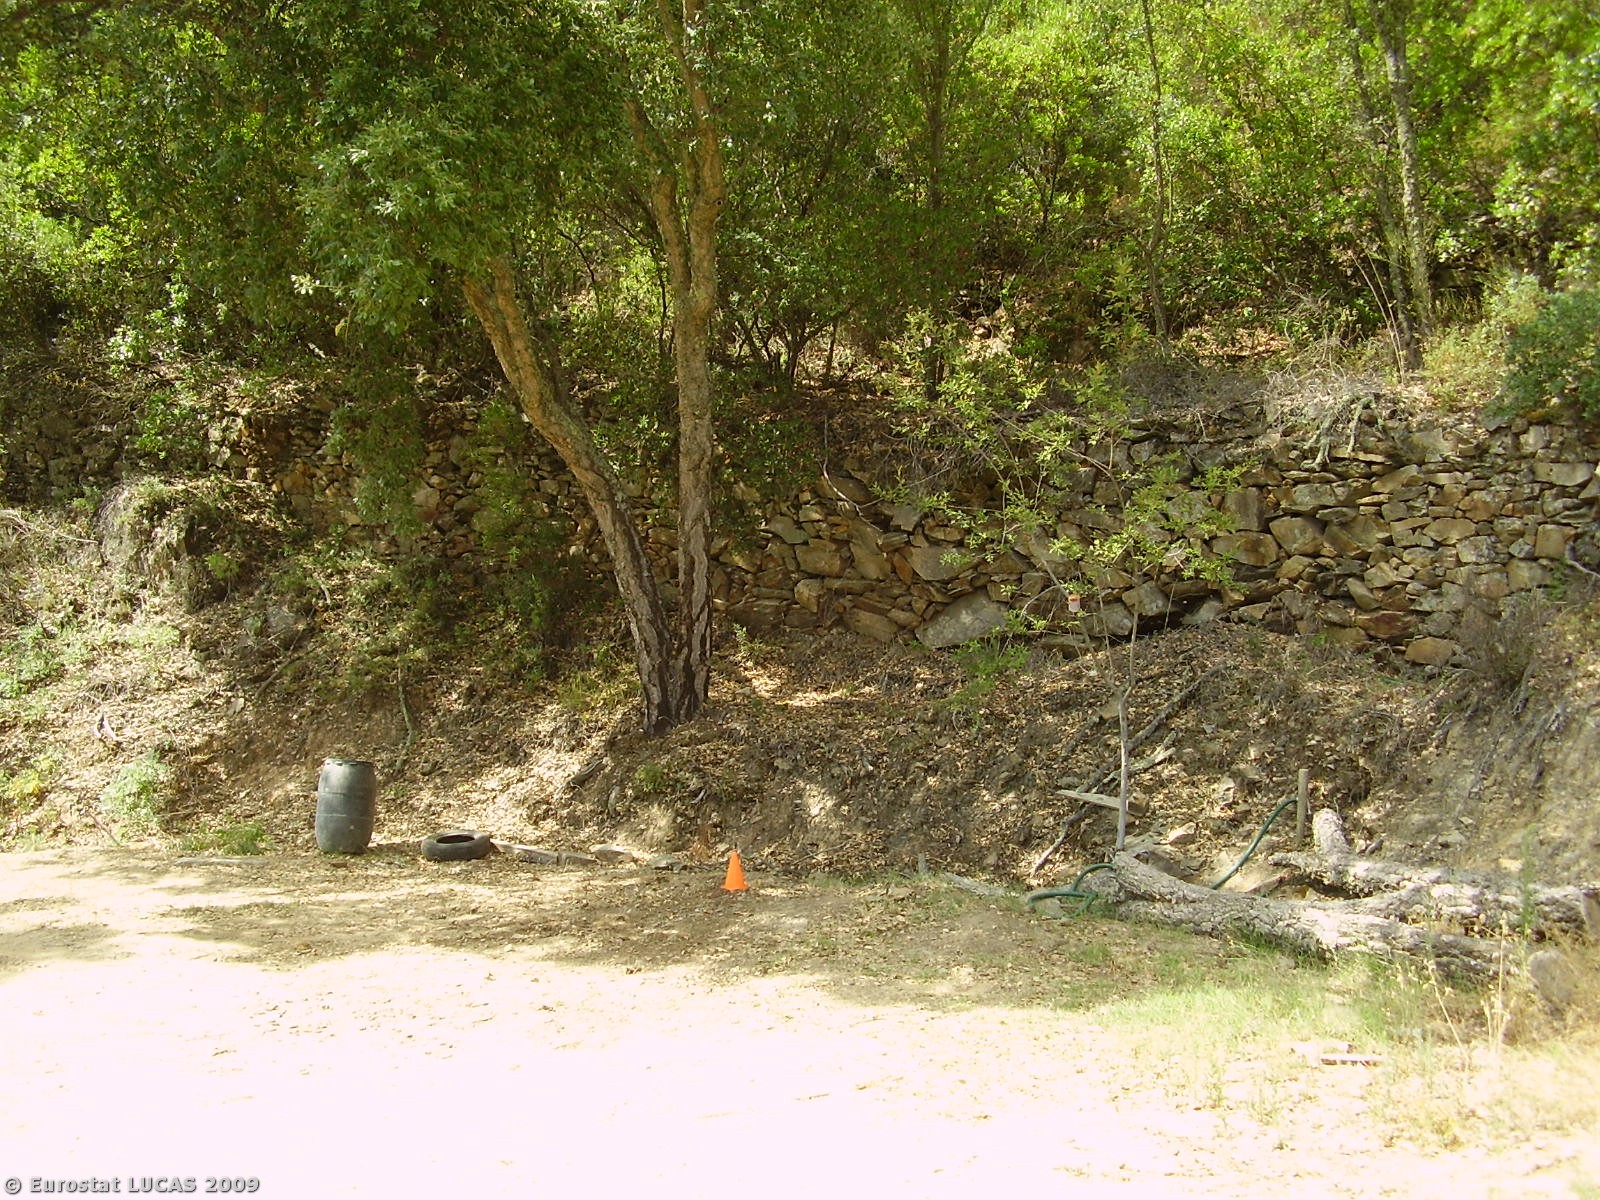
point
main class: Woodland
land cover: Broadleaved woodland
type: broadleaved evergreen forest
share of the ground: > 75 %
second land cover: Spontaneously vegetated surfaces
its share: 10 - 25 %
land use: Unused
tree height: > 5 m
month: July
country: PT
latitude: 41.2188
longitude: -7.6490
